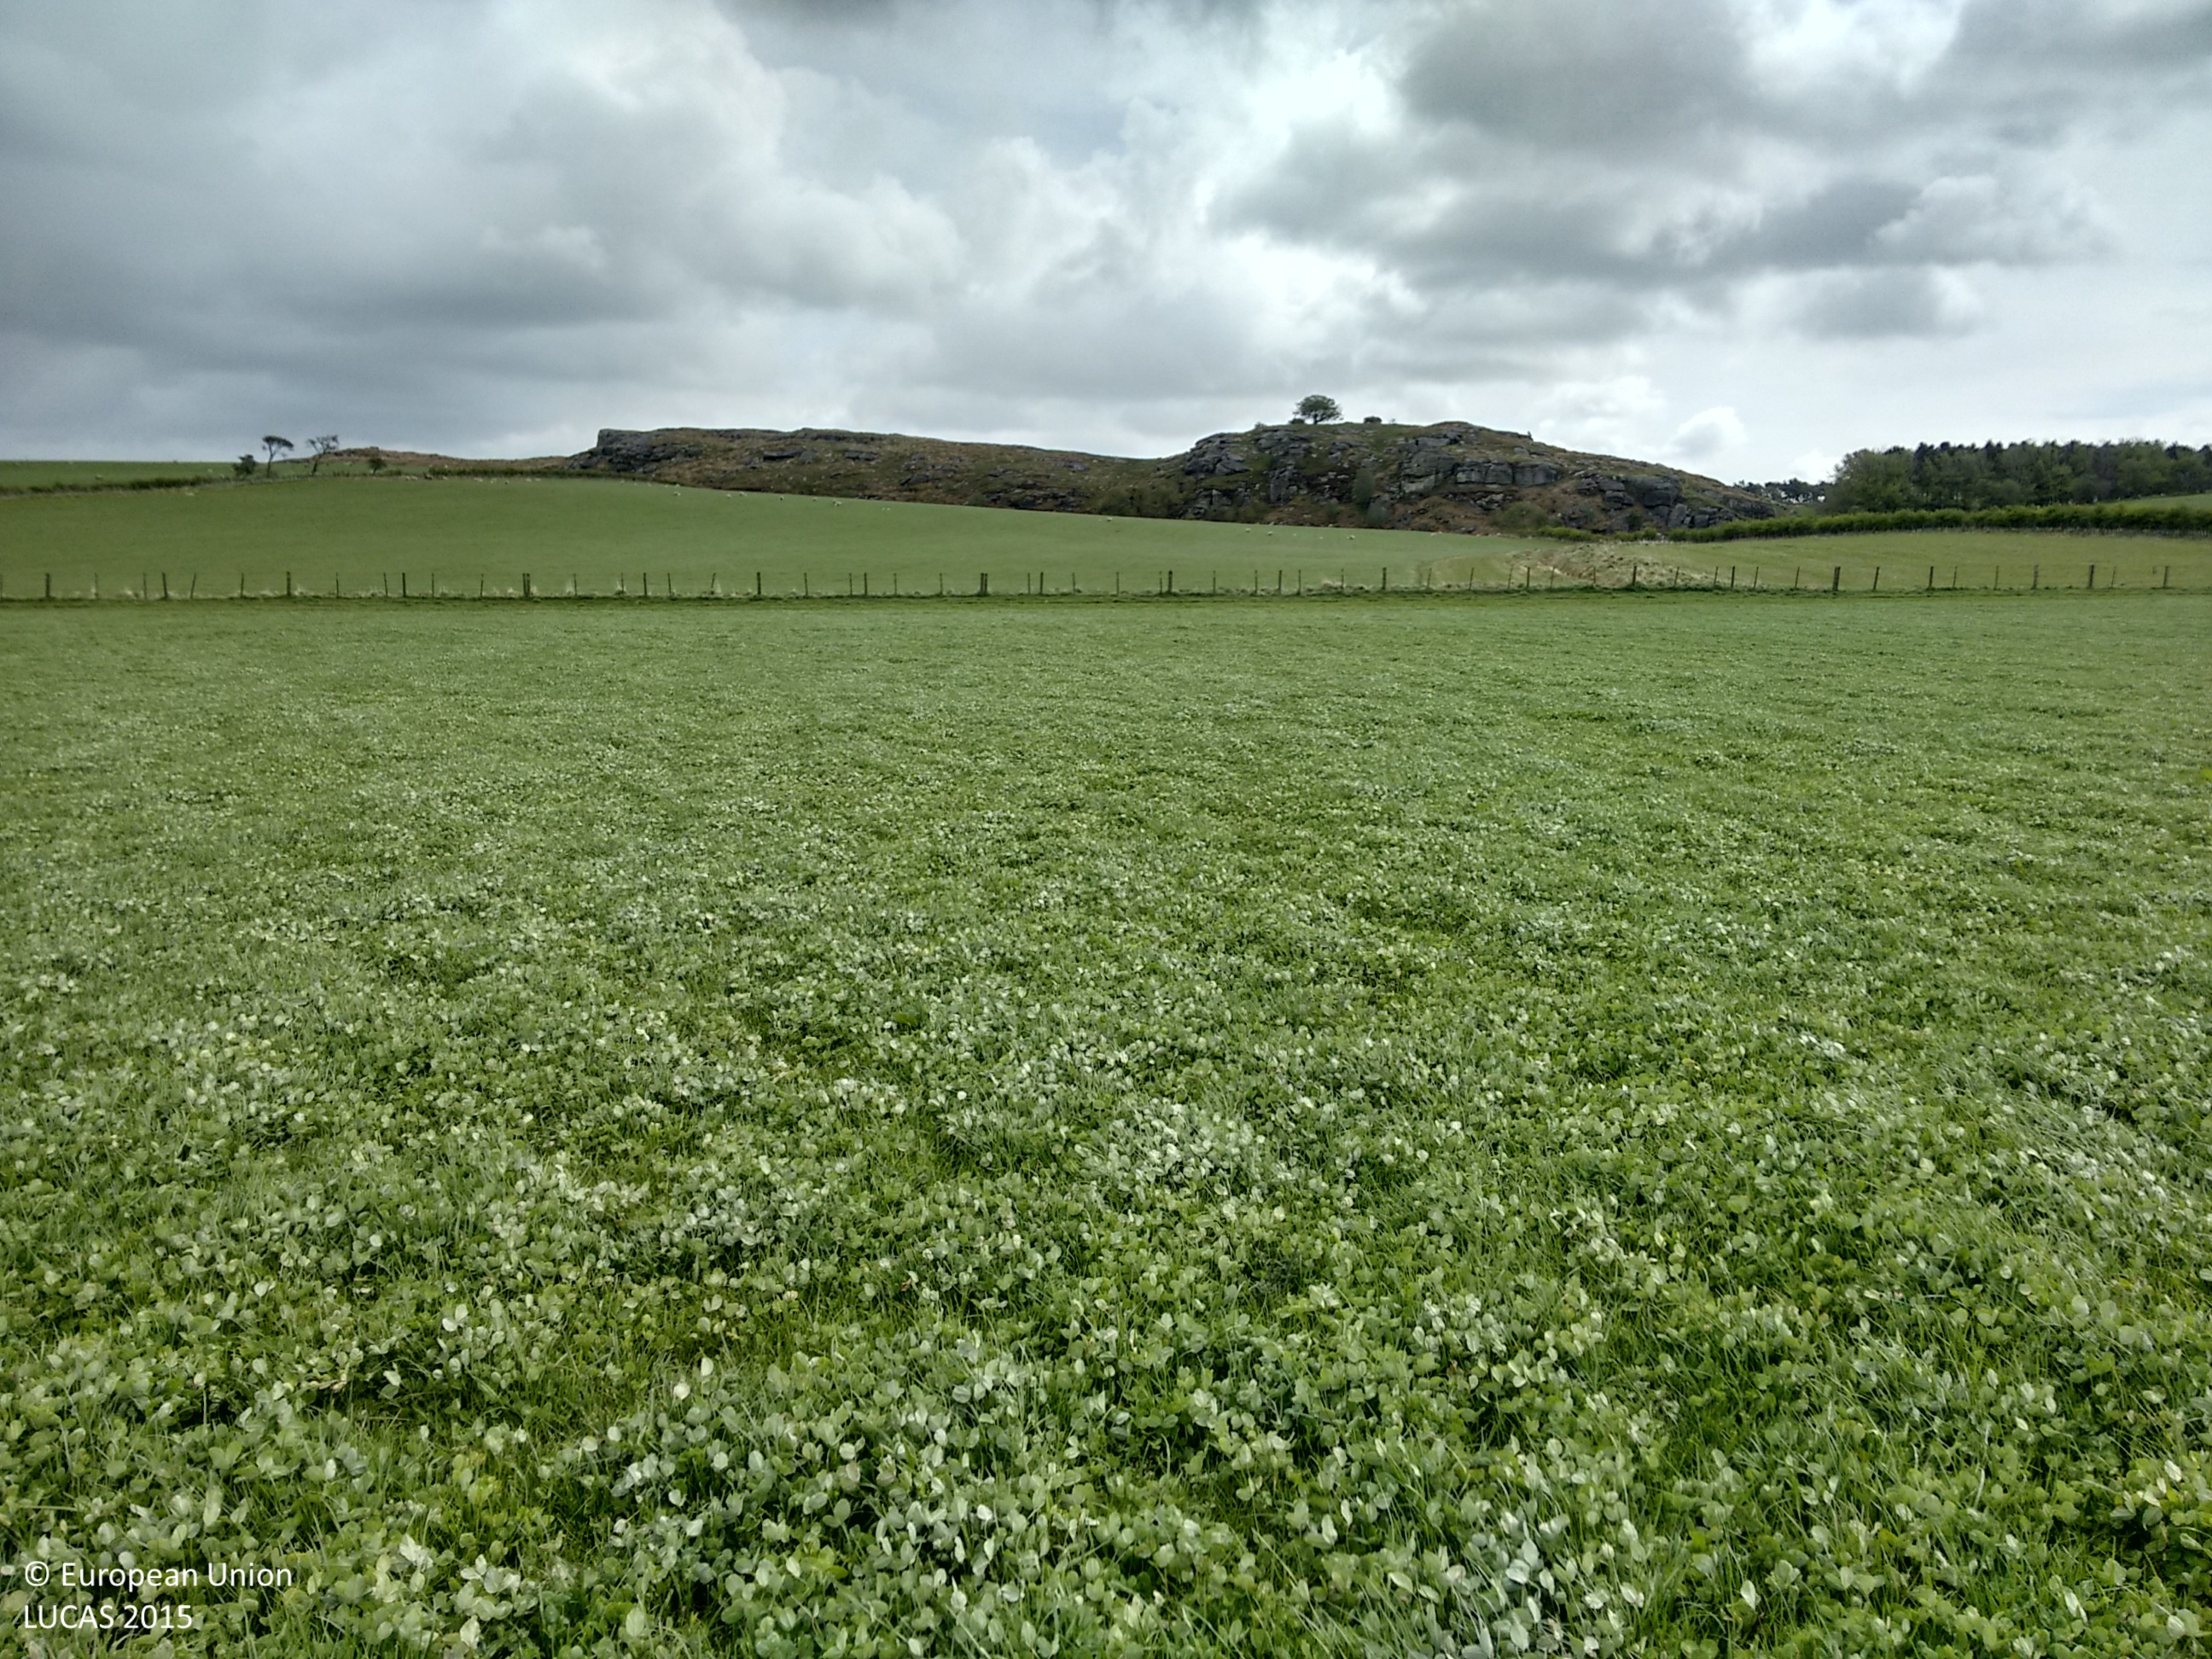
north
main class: Cropland
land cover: Clovers
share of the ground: > 75 %
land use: Agriculture (excluding fallow land and kitchen gardens)
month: May
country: GB
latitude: 55.1908
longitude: -1.9439
